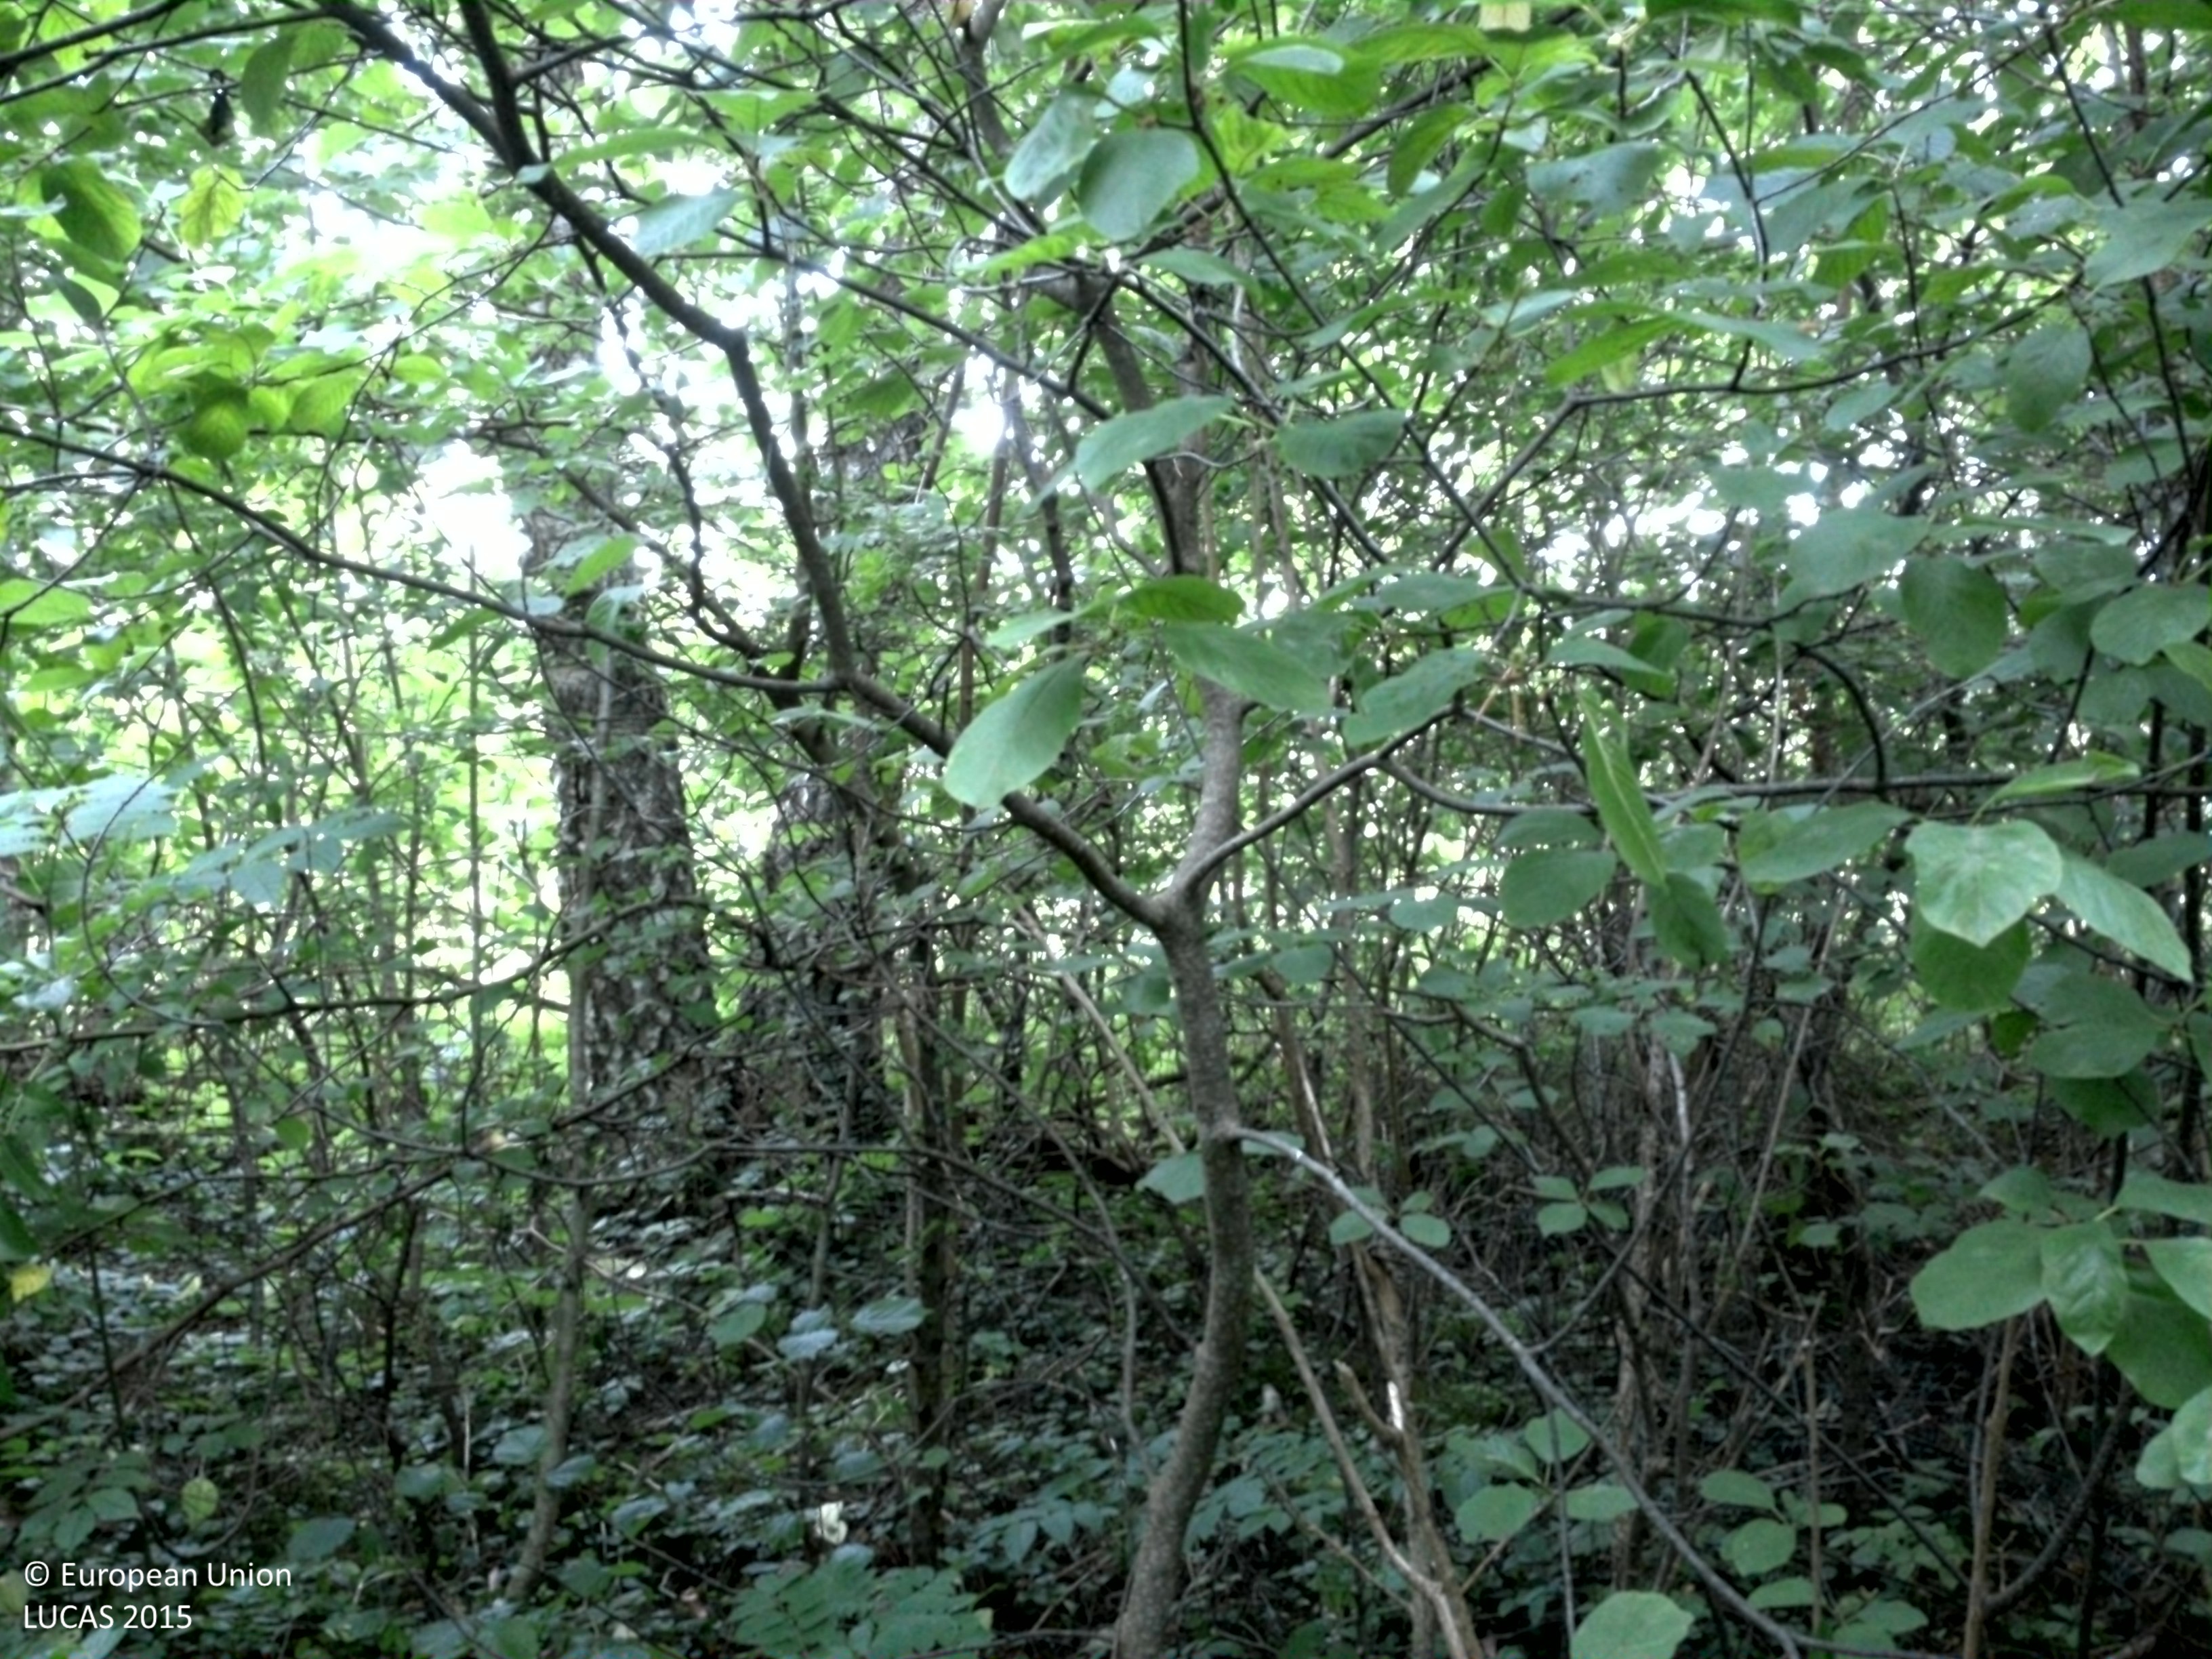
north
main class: Woodland
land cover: Broadleaved woodland
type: mesophytic deciduous forest
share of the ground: > 75 %
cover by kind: broadleaved forest trees 60 %, shrubs 15 %, herbaceous plants 15 %, coniferous forest trees 10 %
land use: Forestry
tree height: > 5 m
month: July
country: SE
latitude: 57.3495
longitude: 18.2673
